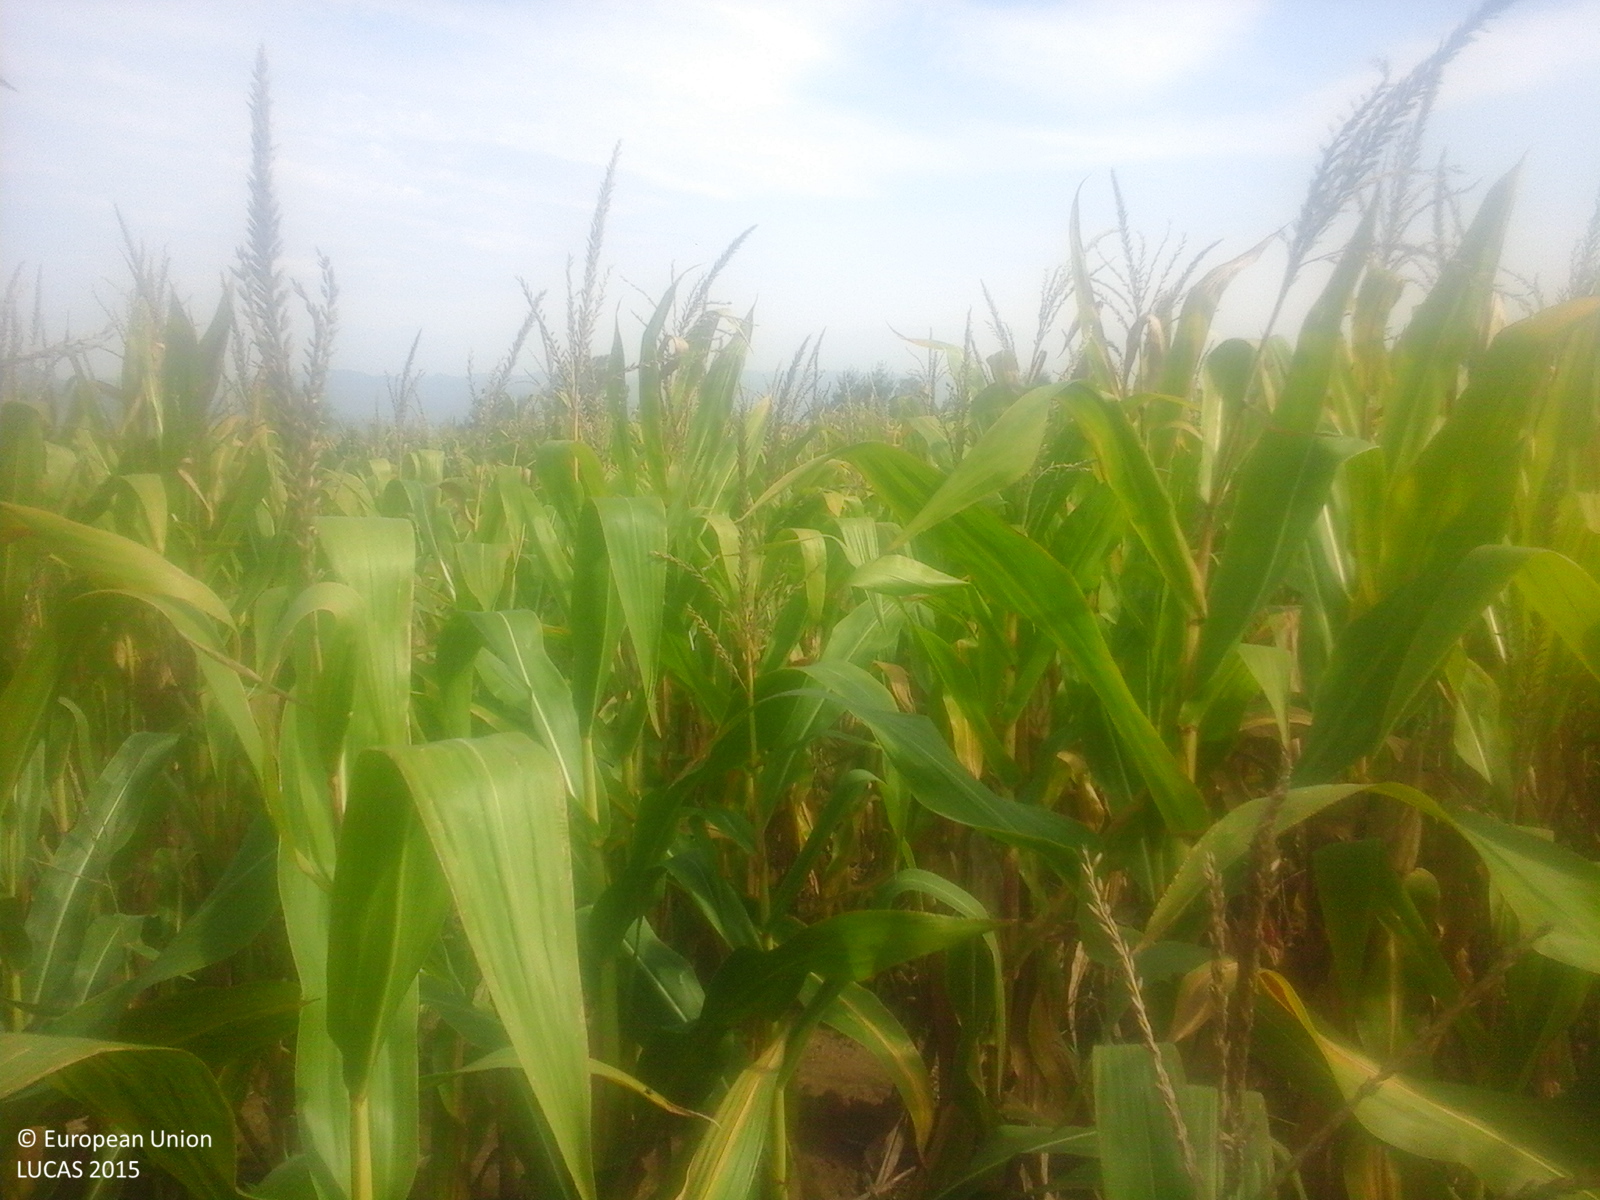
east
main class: Cropland
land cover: Maize
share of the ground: > 75 %
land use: Agriculture (excluding fallow land and kitchen gardens)
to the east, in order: Maize; Spontaneously vegetated surfaces; Maize; Grassland without tree/shrub cover; Spontaneously vegetated surfaces; Grassland with sparse tree/shrub cover; Tracks; Grassland with sparse tree/shrub cover; Spontaneously vegetated surfaces; Shrubland without tree cover; Ditches and canals; Shrubland without tree cover; Maize; Shrubland with sparse tree cover; Grassland with sparse tree/shrub cover; Shrubland with sparse tree cover; Grassland with sparse tree/shrub cover
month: September
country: RO
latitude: 45.5242
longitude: 22.9449
